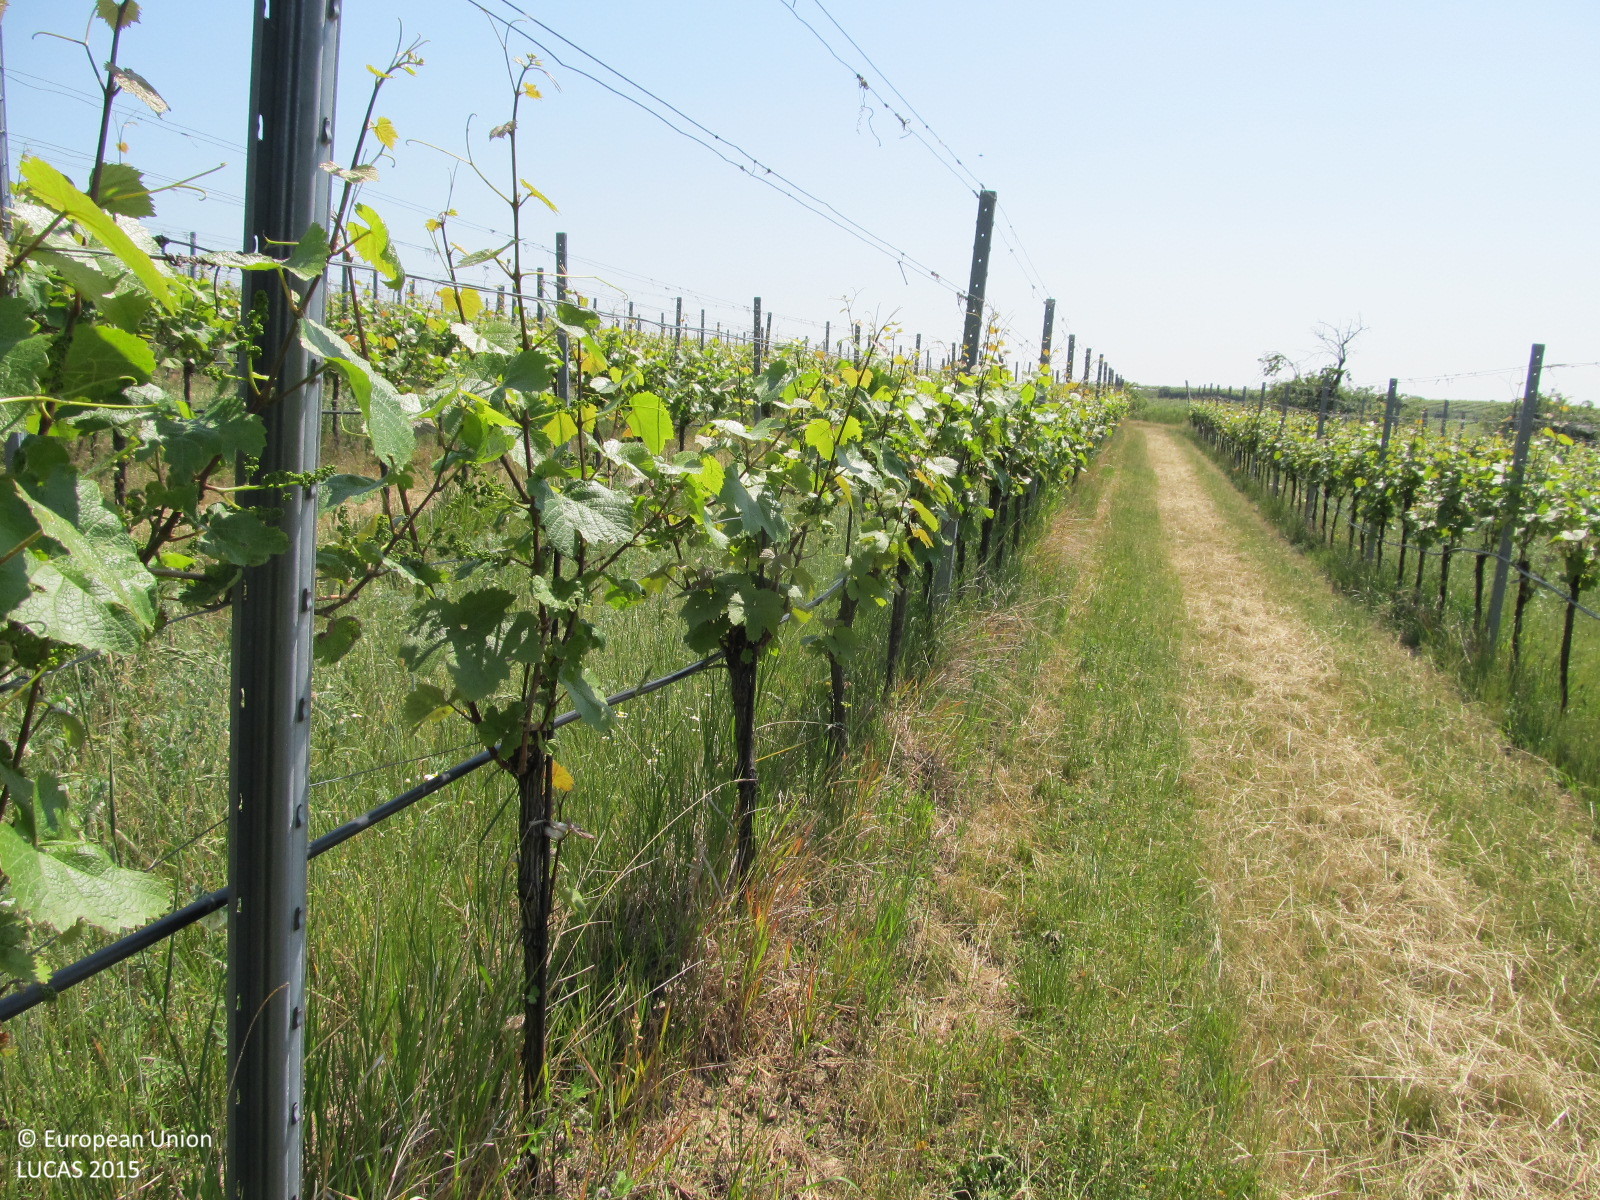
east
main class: Cropland
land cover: Vineyards
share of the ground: 10 - 25 %
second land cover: Grassland without tree/shrub cover
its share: > 75 %
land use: Agriculture (excluding fallow land and kitchen gardens)
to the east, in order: Vineyards; Grassland without tree/shrub cover; Grass margins; Tracks; Grassland without tree/shrub cover; Vineyards; Grassland without tree/shrub cover; Vineyards
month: May
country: AT
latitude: 48.4937
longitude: 15.6460
